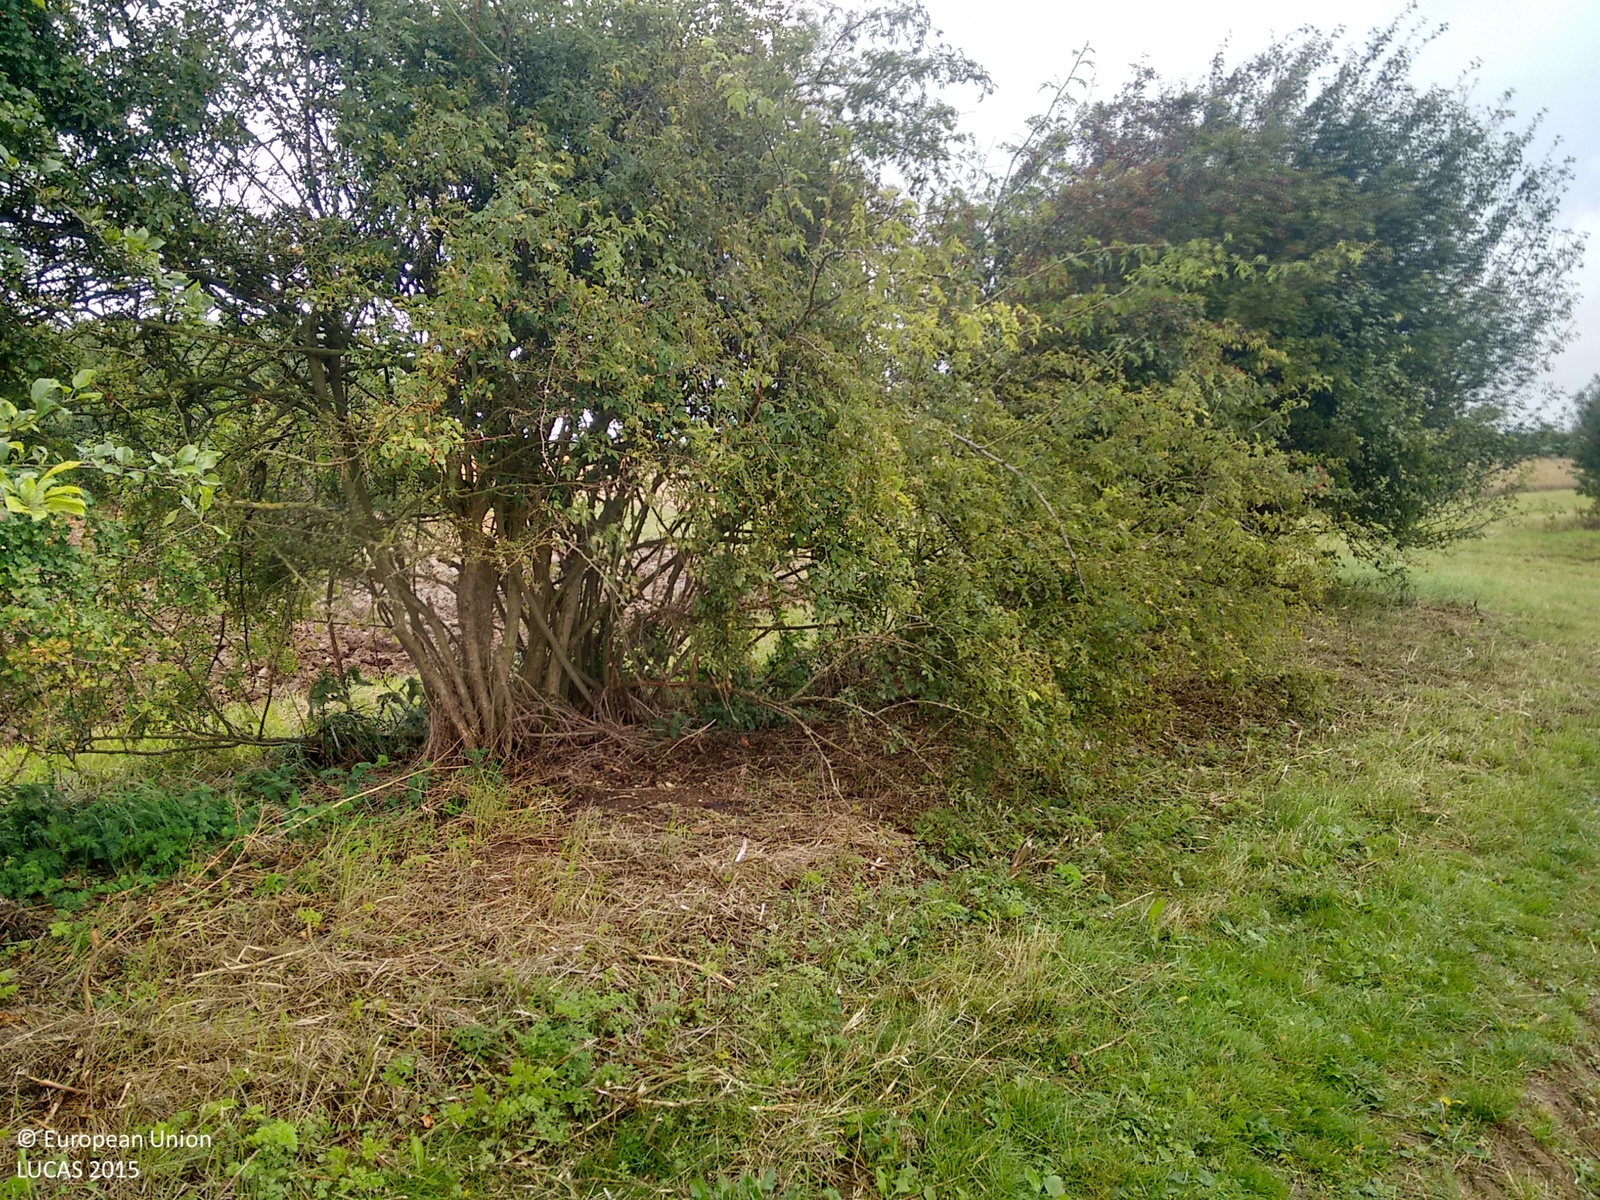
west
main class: Cropland
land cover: Common wheat
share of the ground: > 75 %
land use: Agriculture (excluding fallow land and kitchen gardens)
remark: Harvested field
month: August
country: GB
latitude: 52.1433
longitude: 0.3115
